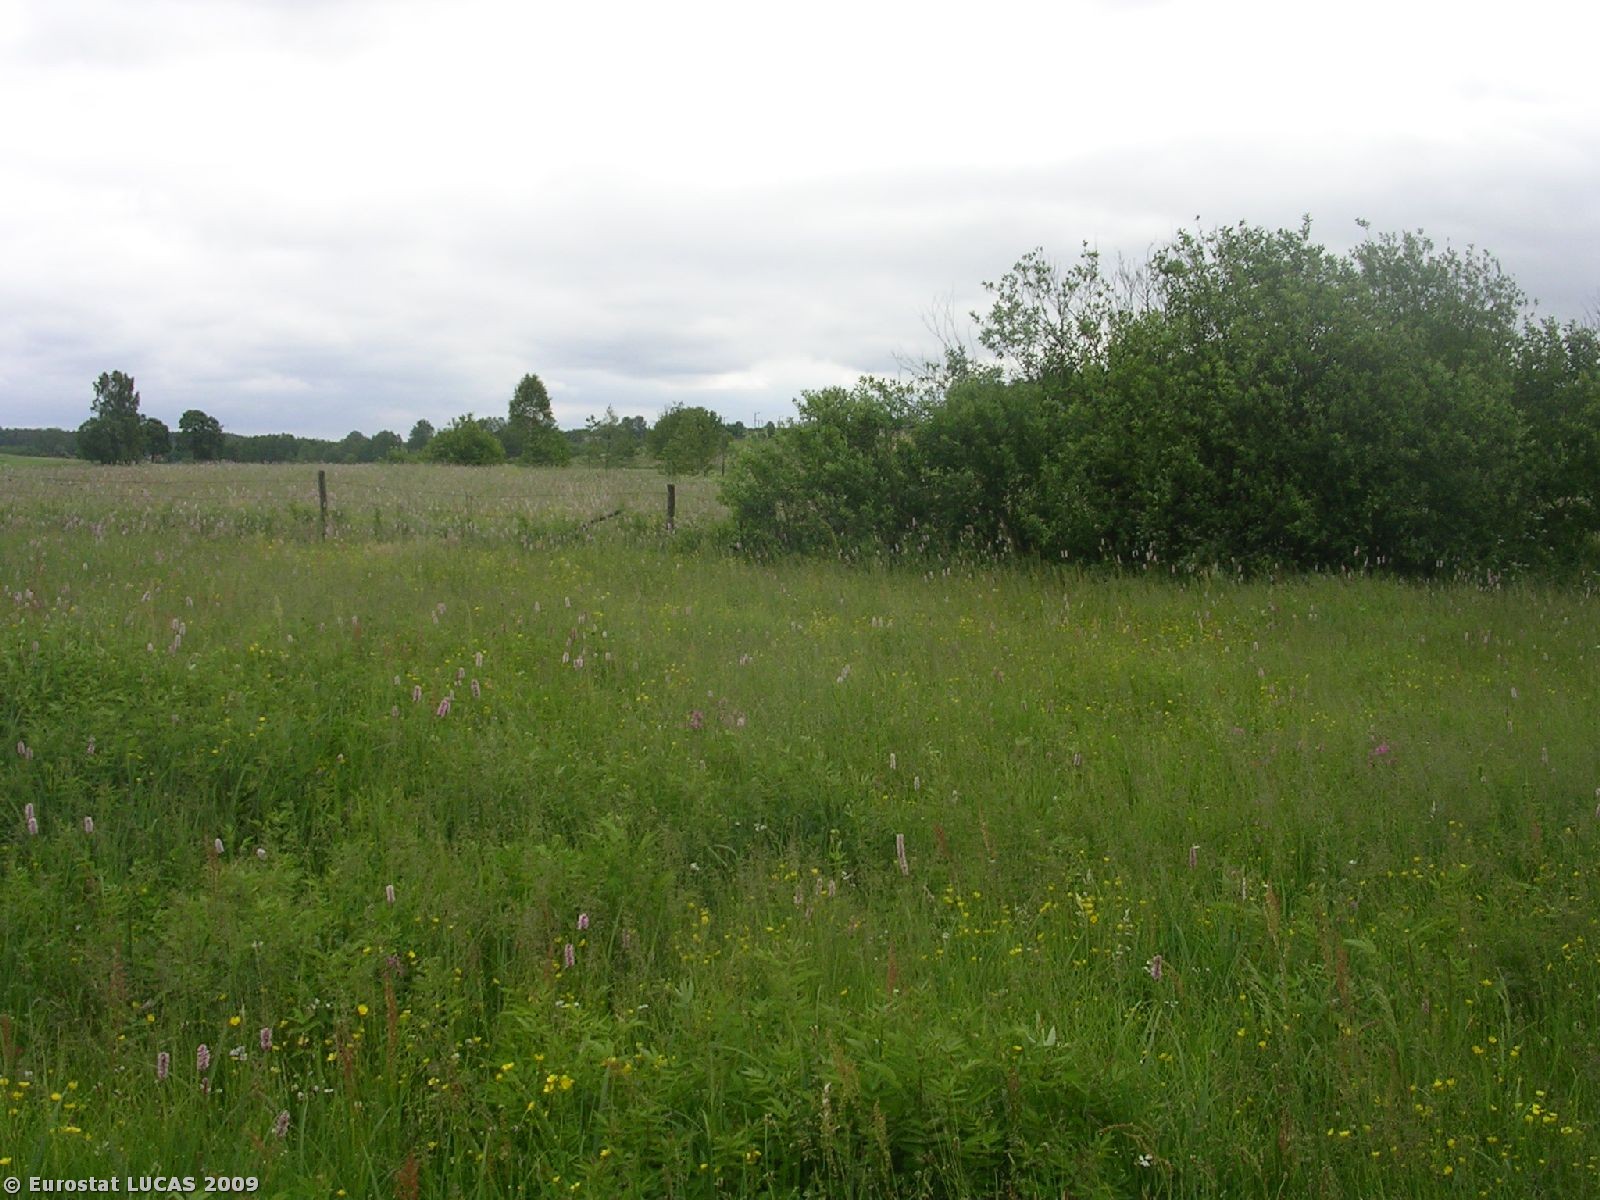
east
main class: Grassland
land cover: Grassland without tree/shrub cover
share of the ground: > 75 %
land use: Agriculture (excluding fallow land and kitchen gardens)
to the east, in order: Grassland without tree/shrub cover; Fences; Ditches and canals; Grassland without tree/shrub cover; Fences; Ditches and canals; Grassland without tree/shrub cover; Fences; Ditches and canals; Grassland without tree/shrub cover
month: June
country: PL
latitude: 53.3804
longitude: 23.4165
